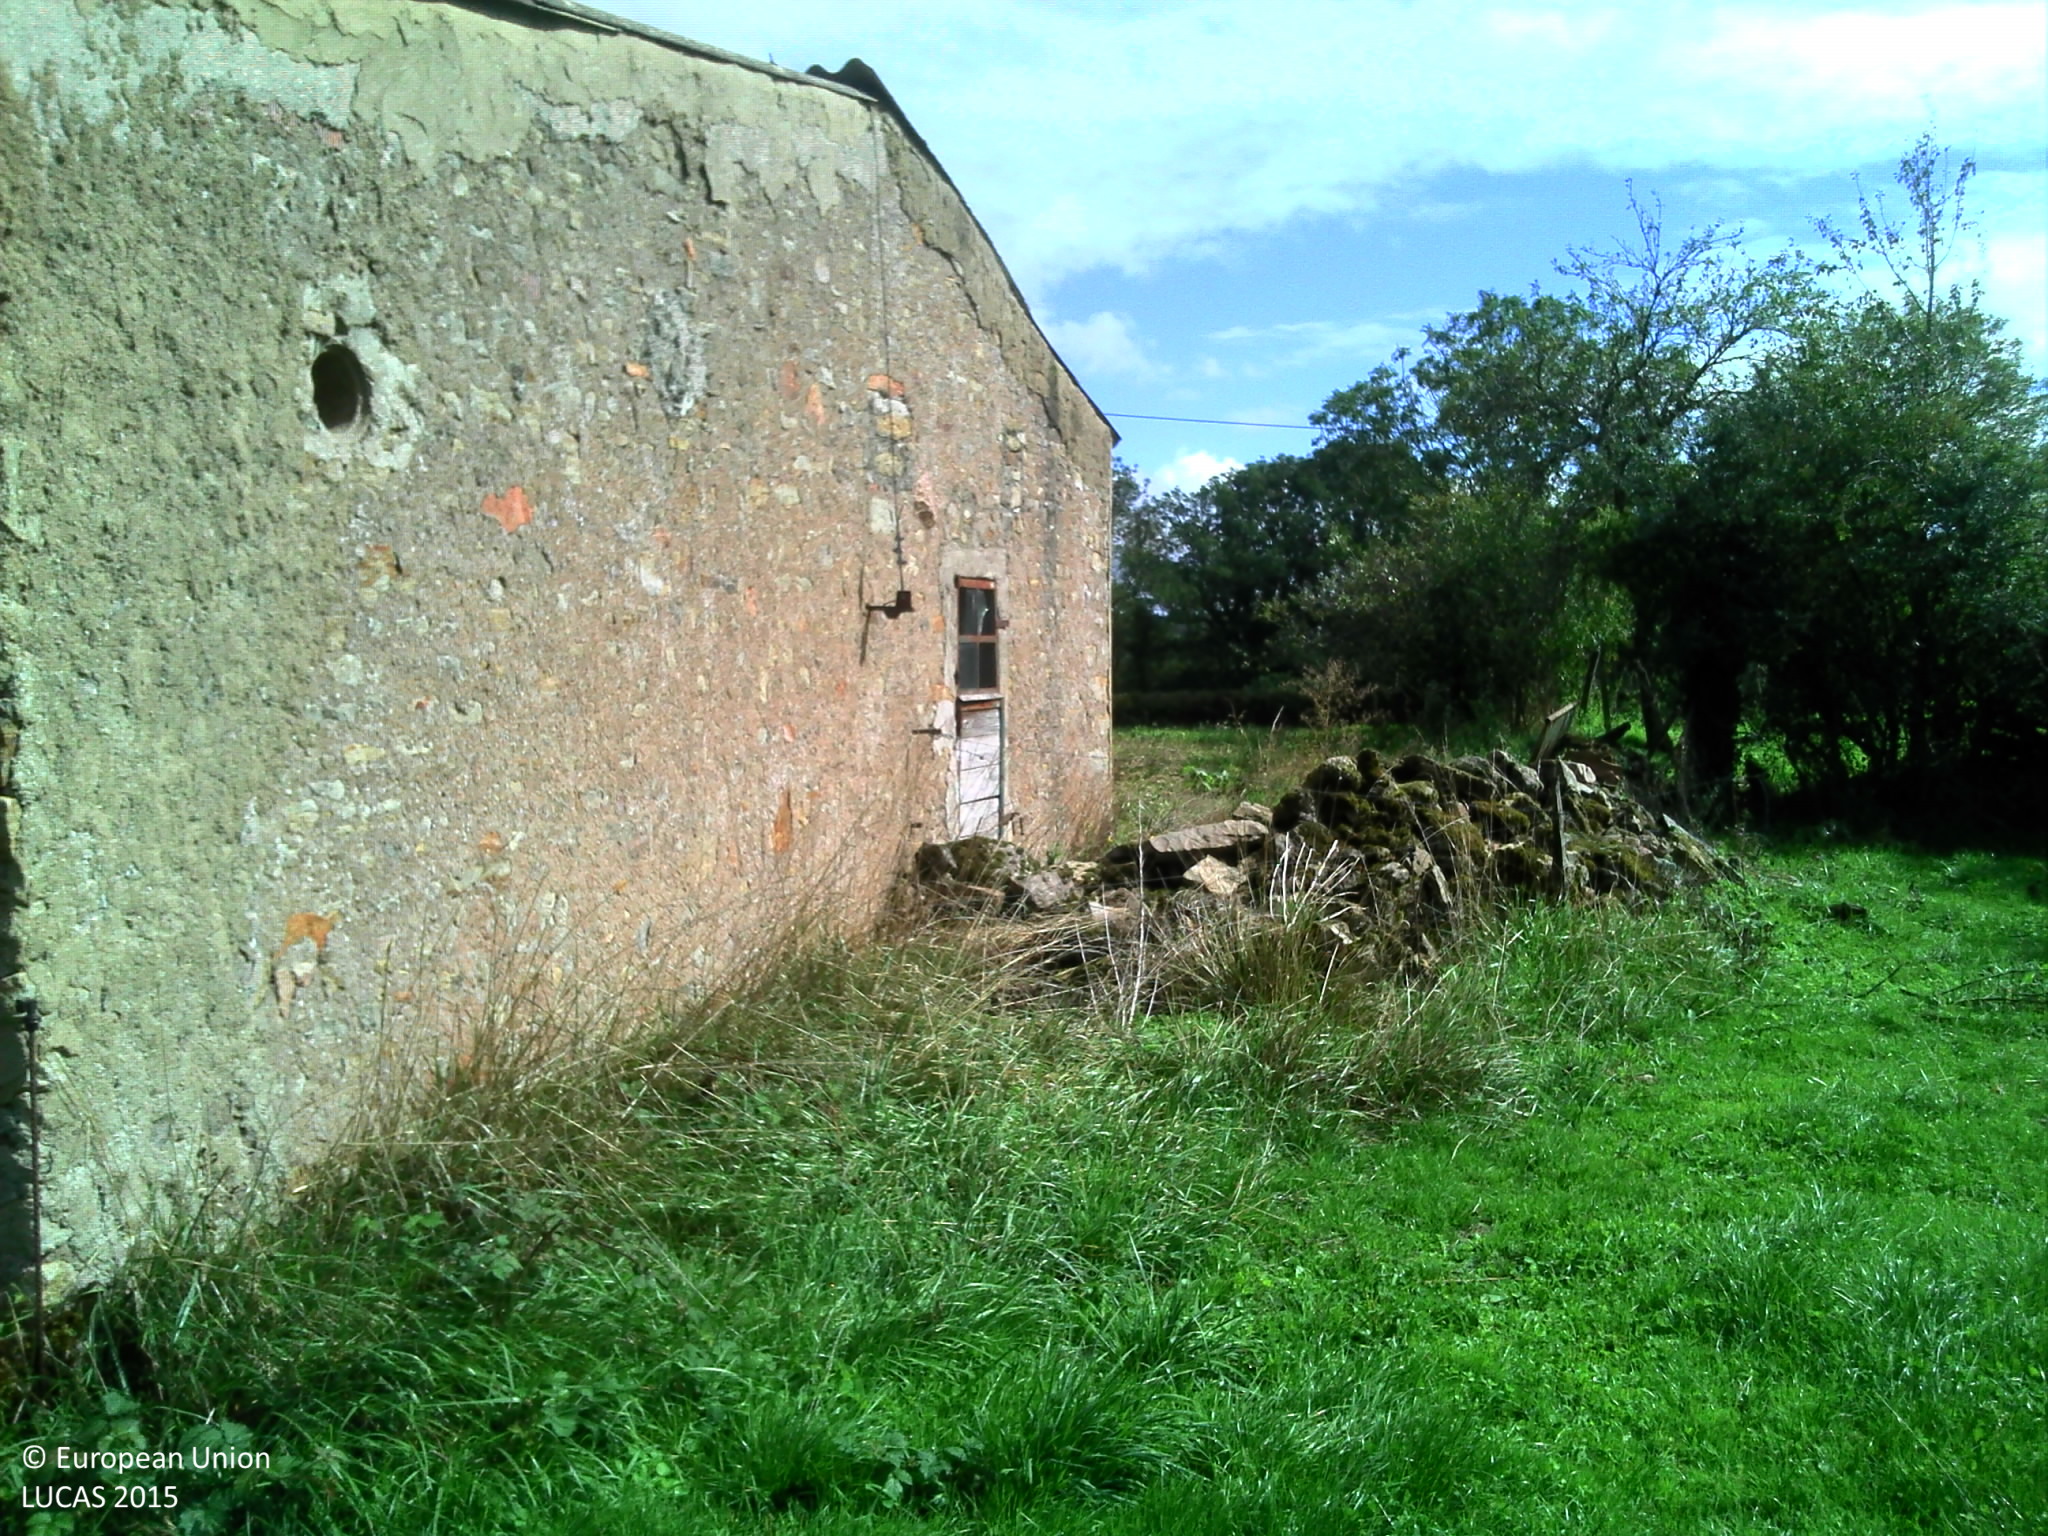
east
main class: Grassland
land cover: Grassland without tree/shrub cover
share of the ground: > 75 %
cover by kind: herbaceous plants 100 %
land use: Agriculture (excluding fallow land and kitchen gardens)
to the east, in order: Grassland without tree/shrub cover; Fences; Dry stone walls; Spontaneously vegetated surfaces; Fences; Grass margins; Electric lines; Paved roads, cycling and walking lanes; Grass margins; Lines of trees; Managed hedges; Fences; Grassland without tree/shrub cover; Fences; Broadleaved woodland; Tracks; Broadleaved woodland; Ditches and canals; Fences; Broadleaved woodland; Grassland without tree/shrub cover
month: September
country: FR
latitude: 47.2298
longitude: 4.3332
